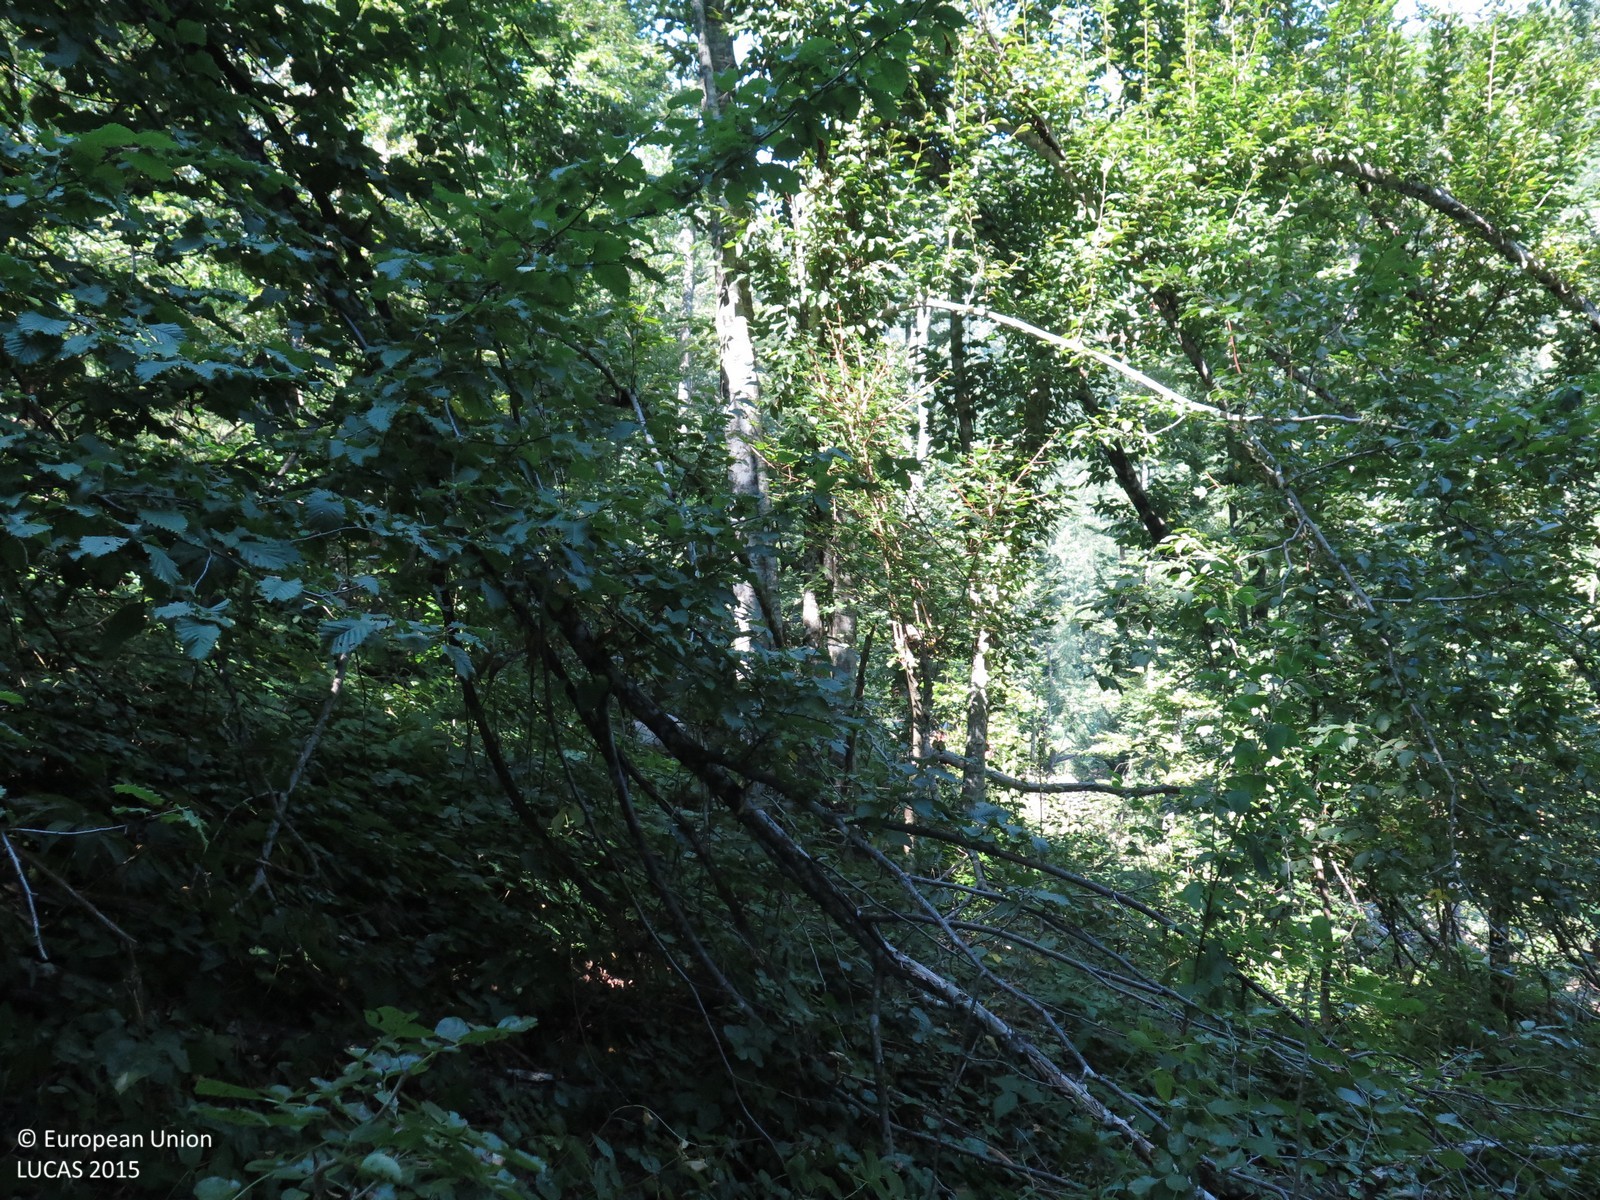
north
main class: Woodland
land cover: Broadleaved woodland
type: beech forest
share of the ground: > 75 %
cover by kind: broadleaved forest trees 95 %, herbaceous plants 5 %
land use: Semi-natural and natural areas not in use
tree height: > 5 m
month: August
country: HR
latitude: 45.4306
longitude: 15.1979
